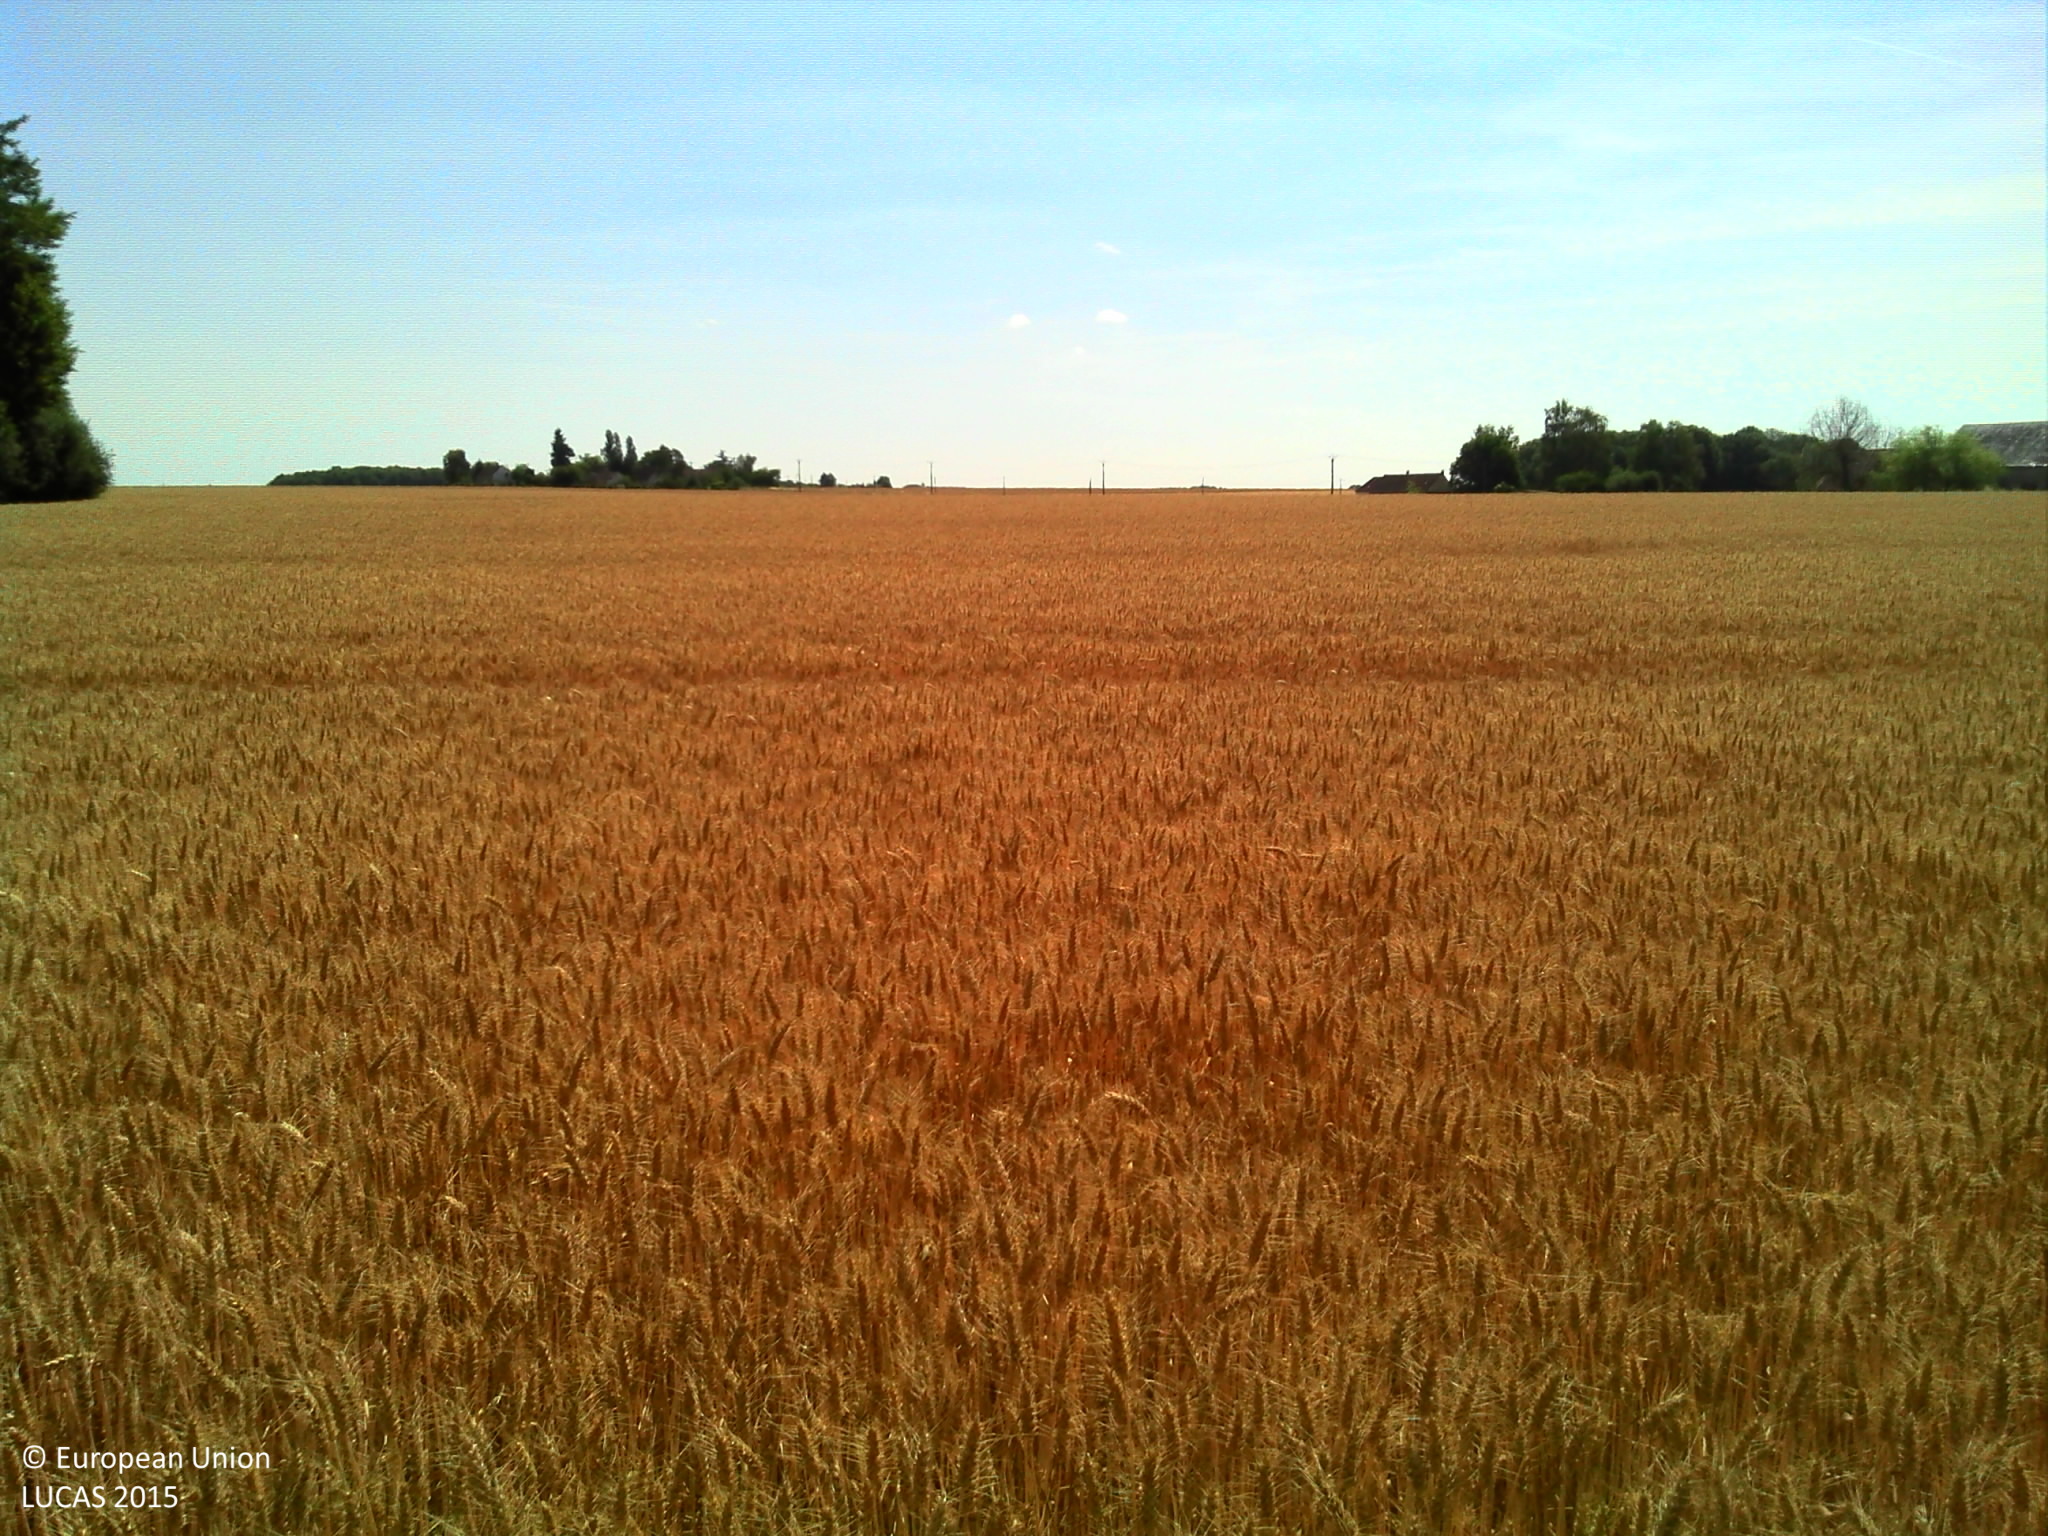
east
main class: Cropland
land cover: Common wheat
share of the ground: > 75 %
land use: Agriculture (excluding fallow land and kitchen gardens)
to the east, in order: Common wheat
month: July
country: FR
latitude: 47.9871
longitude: 3.0658
